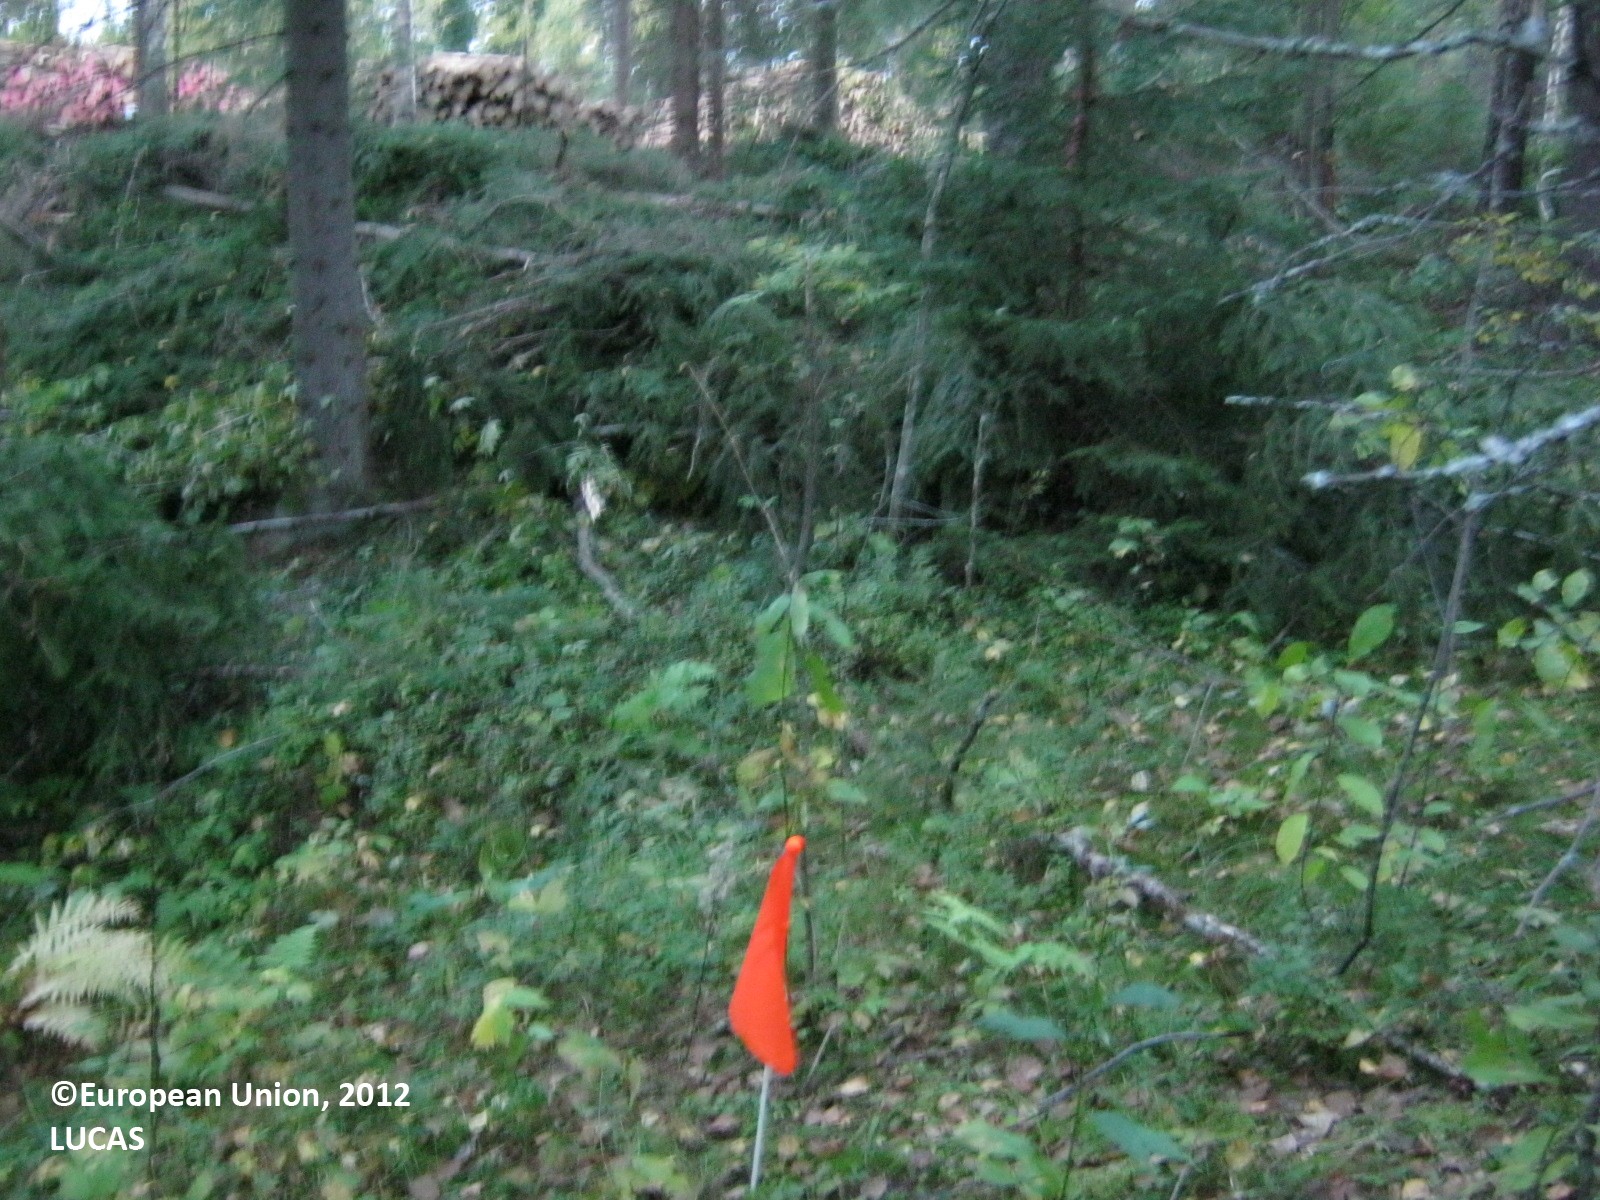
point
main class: Woodland
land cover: Broadleaved woodland
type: boreal forest
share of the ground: > 75 %
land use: Forestry
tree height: > 5 m
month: September
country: FI
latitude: 60.7275
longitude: 27.8900
